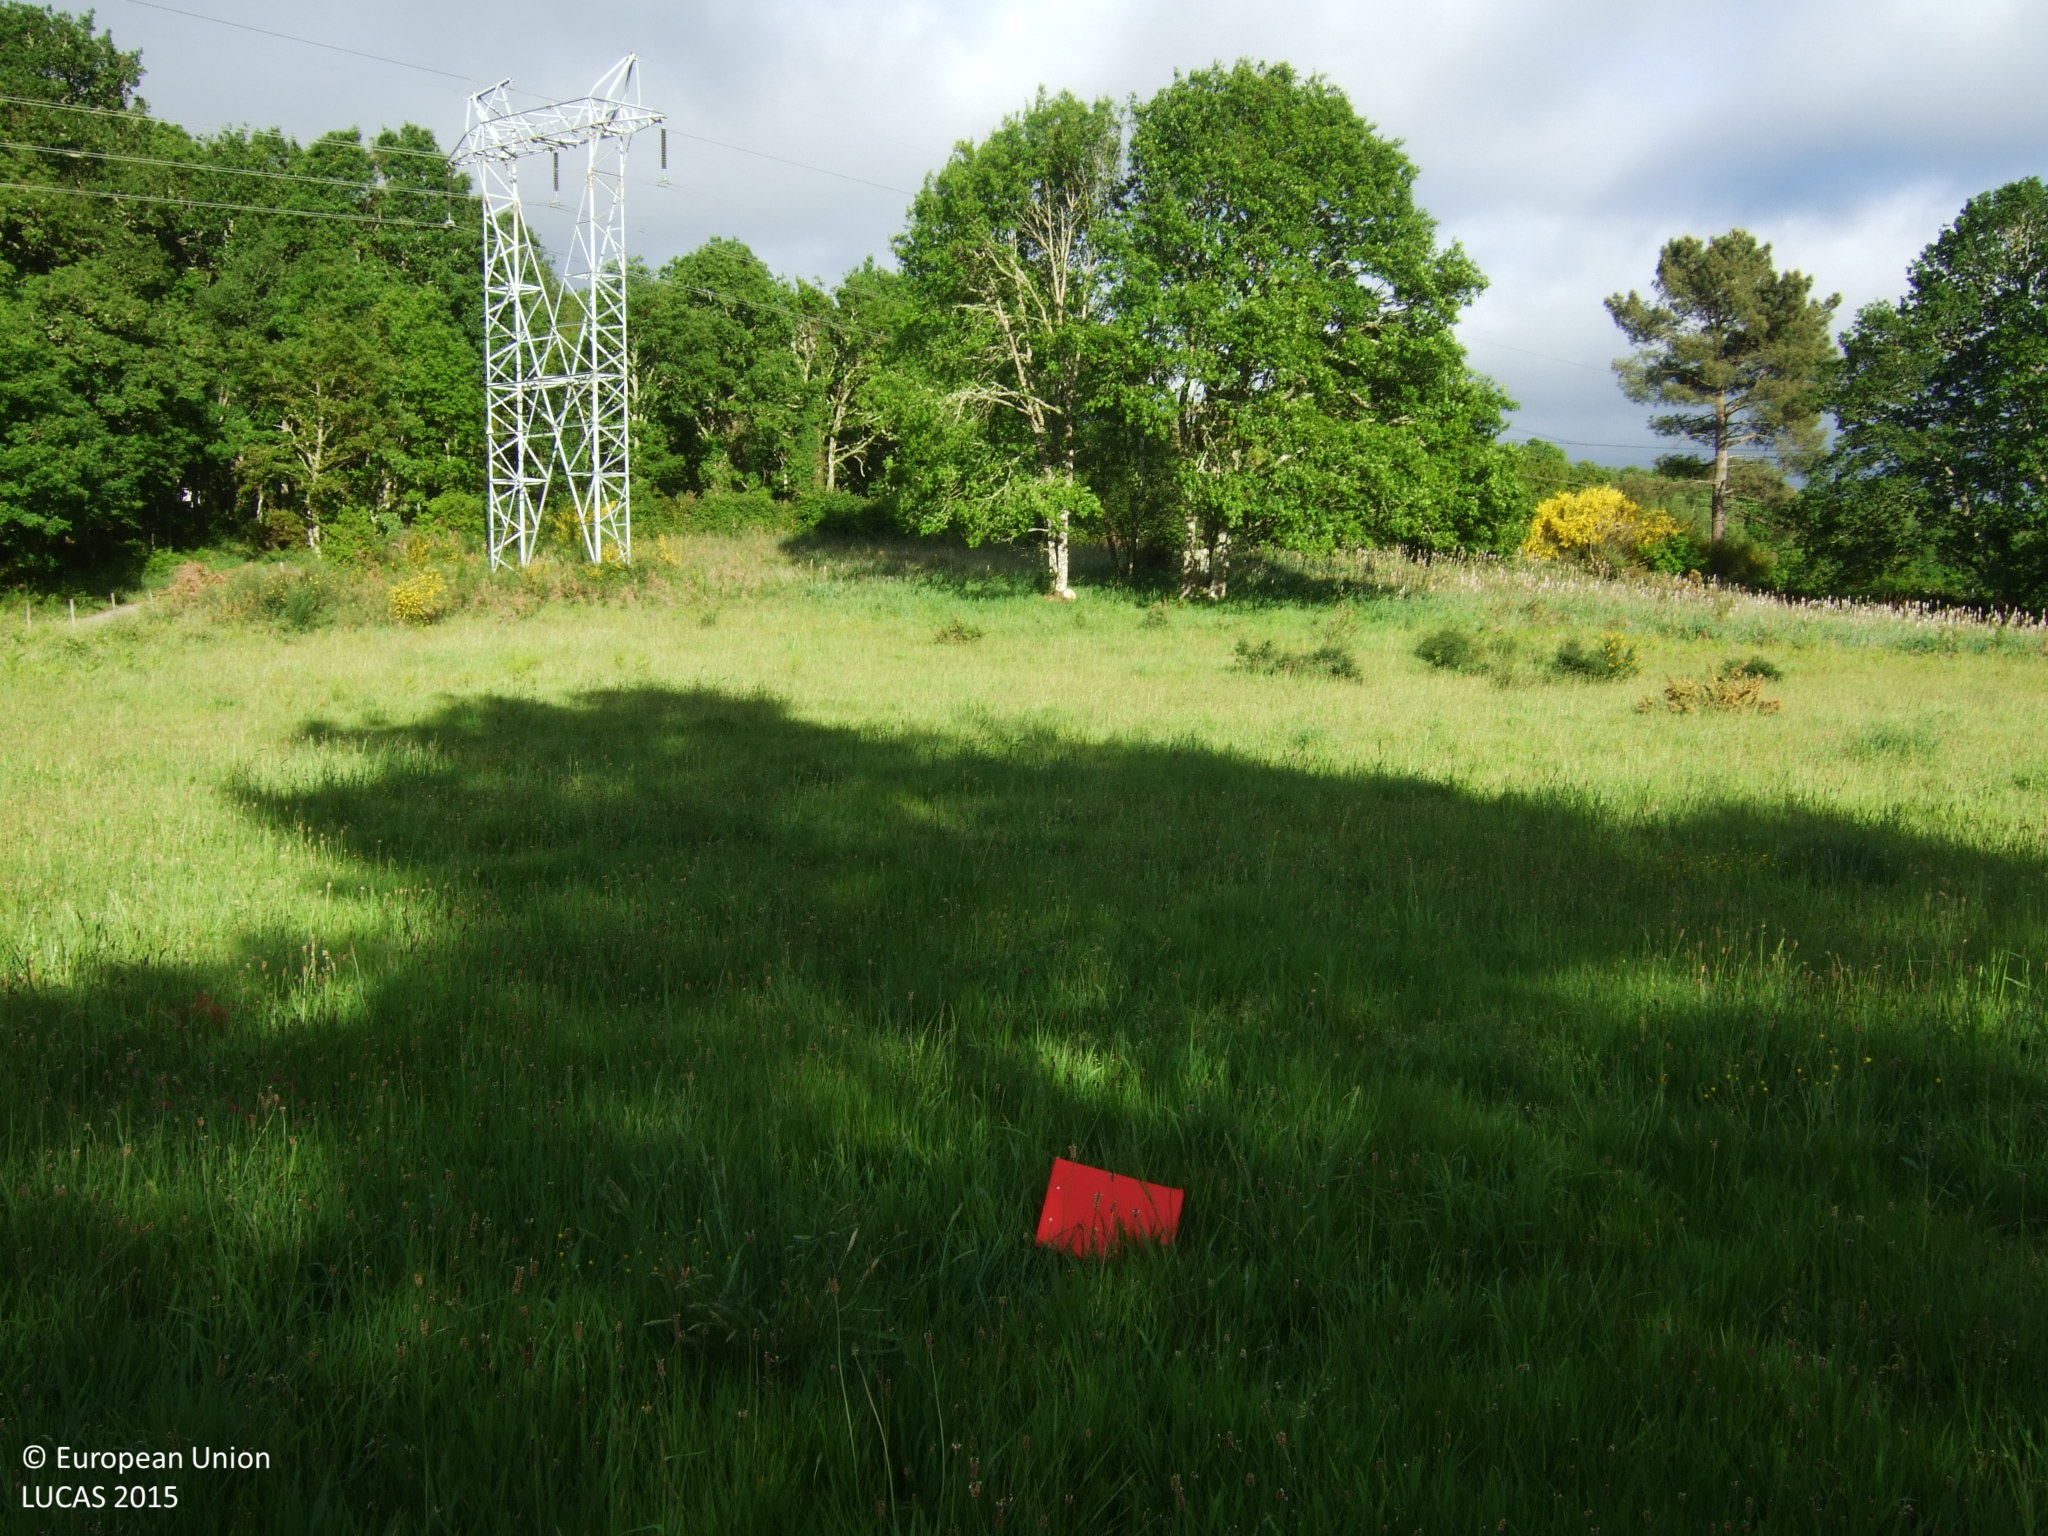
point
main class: Grassland
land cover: Grassland without tree/shrub cover
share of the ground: > 75 %
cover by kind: herbaceous plants 100 %
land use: Agriculture (excluding fallow land and kitchen gardens)
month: May
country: ES
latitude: 43.2852
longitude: -7.7461
